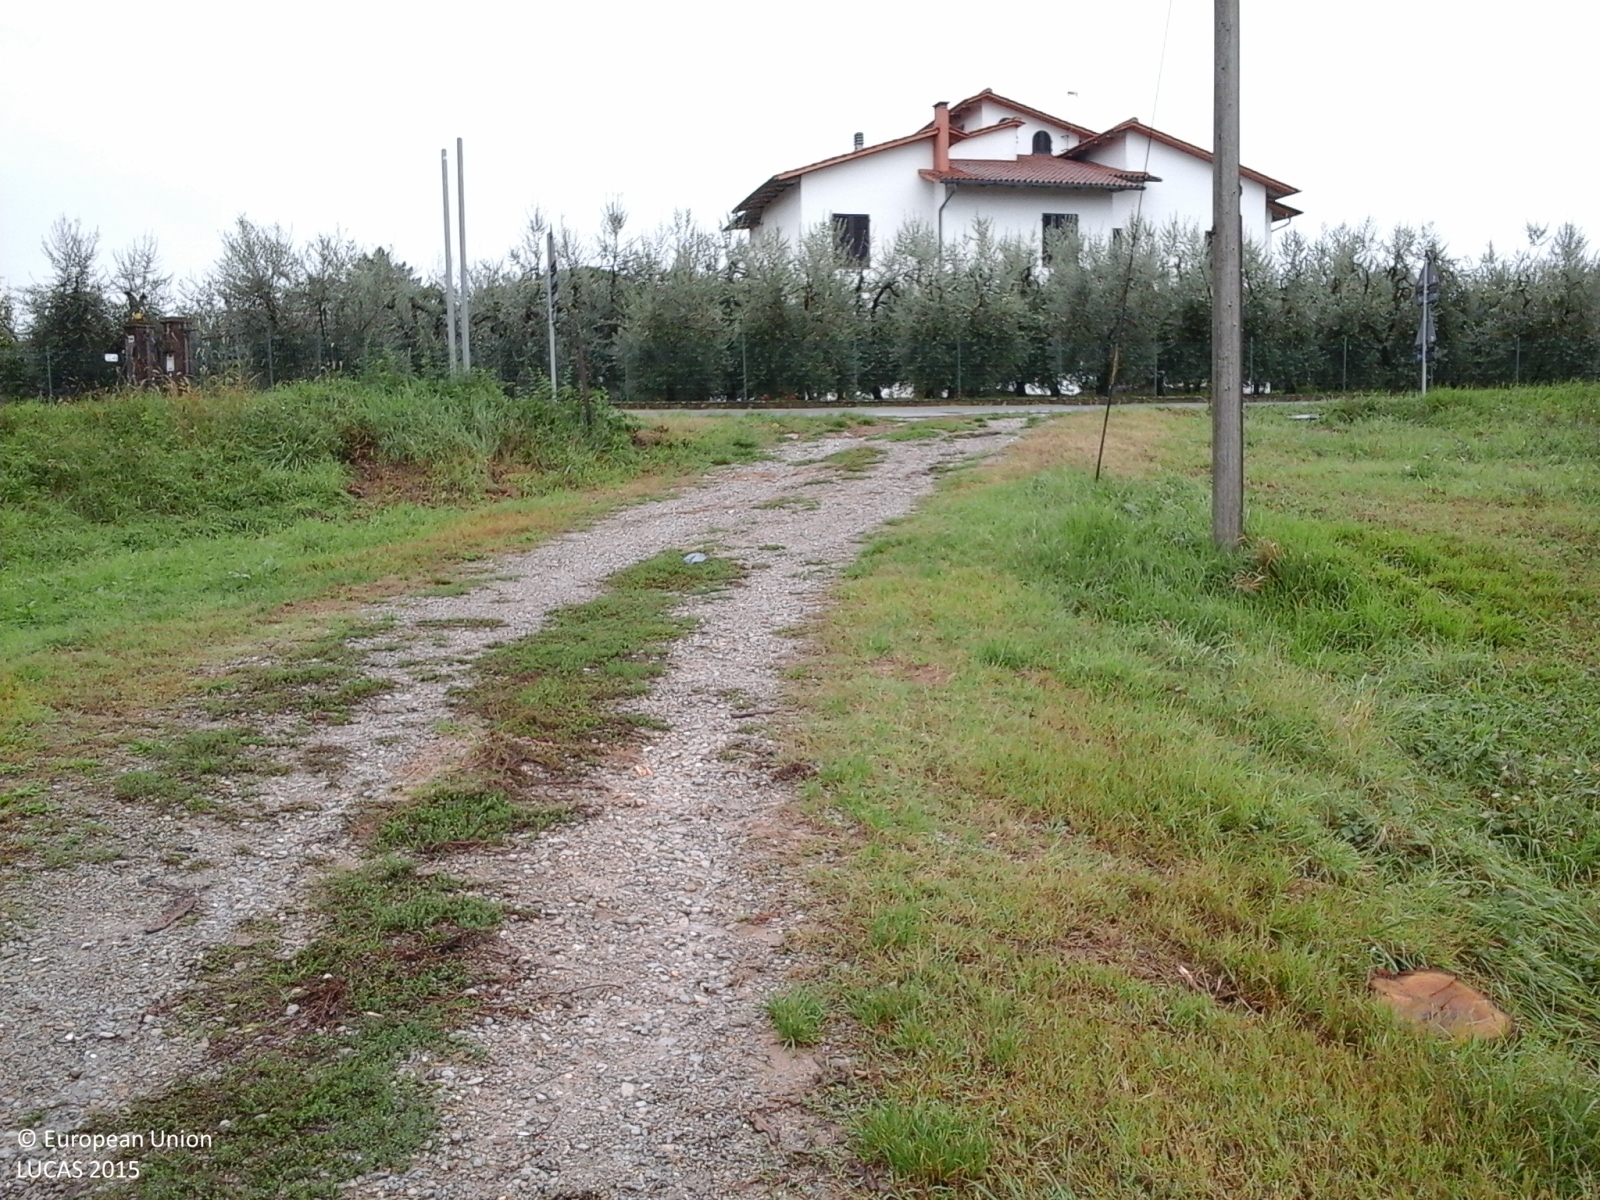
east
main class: Woodland
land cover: Broadleaved woodland
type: thermophilous deciduous forest
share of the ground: > 75 %
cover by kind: broadleaved forest trees 90 %, shrubs 10 %
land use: Forestry
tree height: > 5 m
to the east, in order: Broadleaved woodland; Shrubland with sparse tree cover; Broadleaved woodland; Grassland without tree/shrub cover; Fences; Tracks; Olive groves; Grassland without tree/shrub cover; Abandoned hedges; Grass margins; Paved roads, cycling and walking lanes; Grass margins; Fences; Olive groves; Fences; Ditches and canals; Grassland without tree/shrub cover
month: October
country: IT
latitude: 43.5278
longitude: 11.4931
